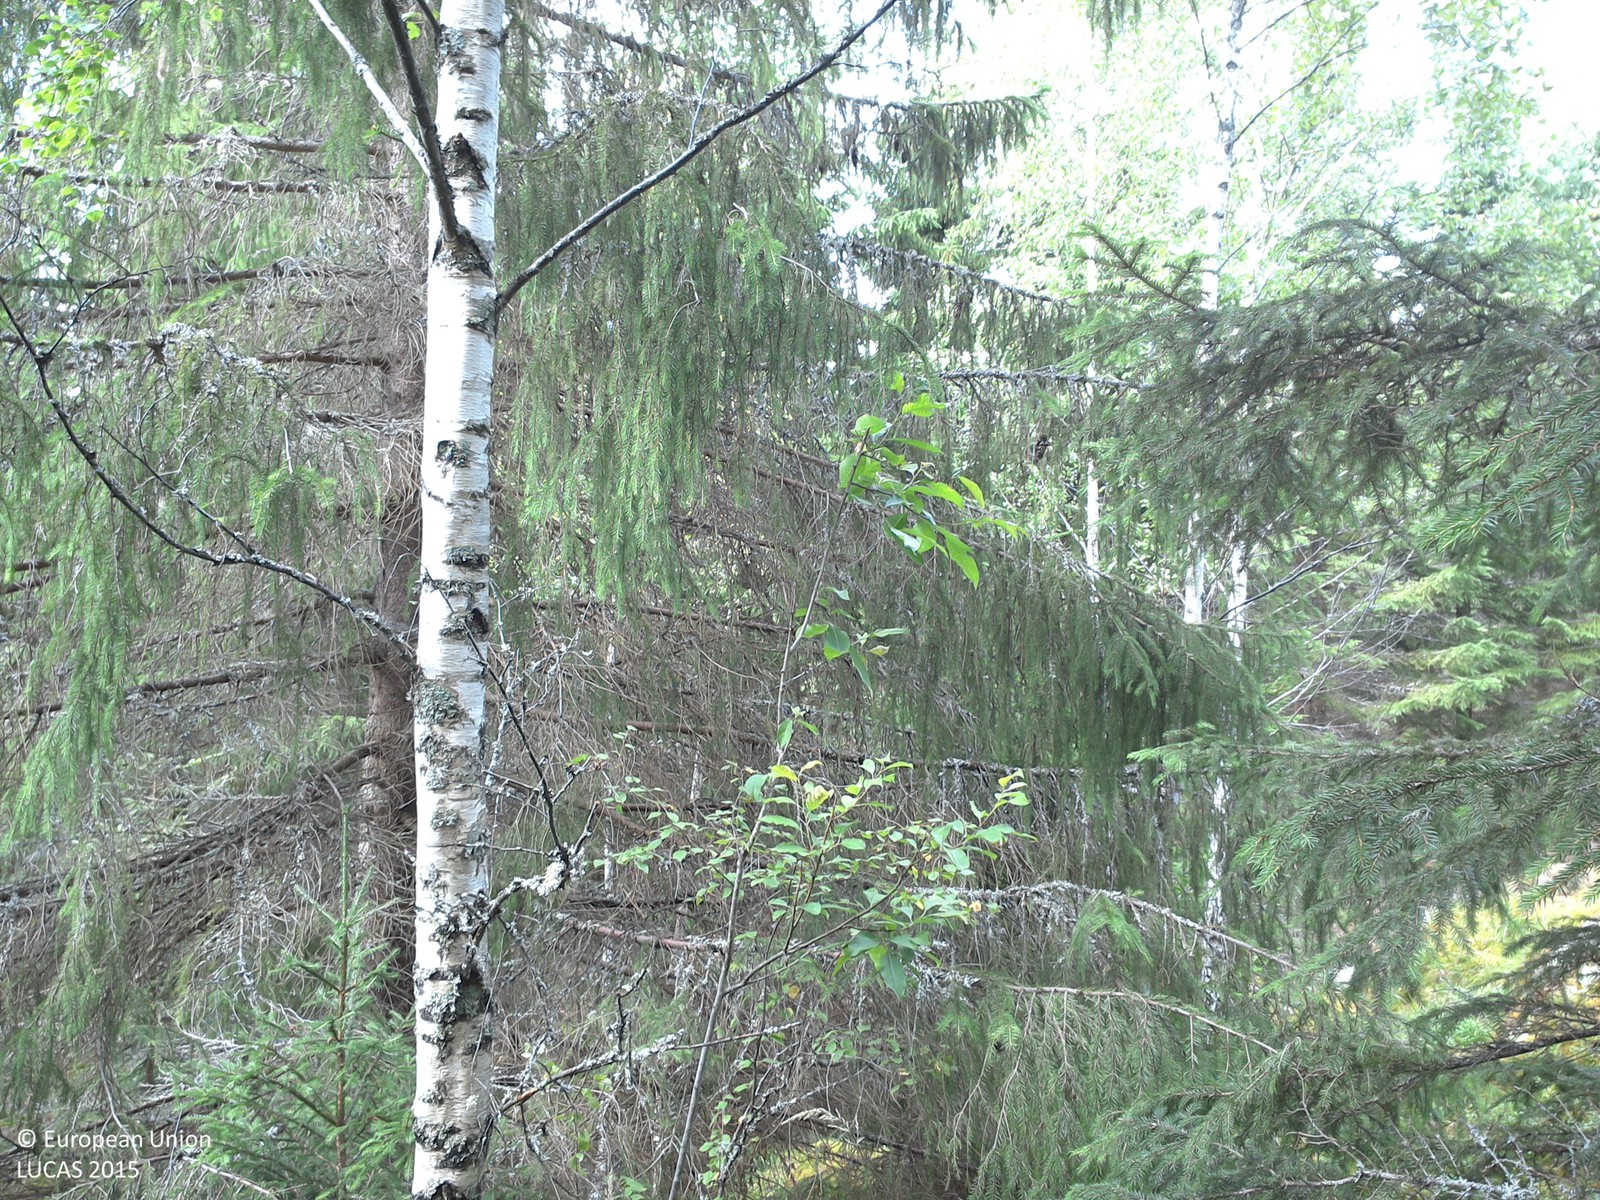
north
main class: Woodland
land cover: Spruce dominated coniferous woodland
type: boreal forest
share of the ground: 50 - 75 %
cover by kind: coniferous forest trees 60 %, lichens and mosses 30 %, herbaceous plants 10 %
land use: Forestry
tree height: > 5 m
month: August
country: SE
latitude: 58.1286
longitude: 15.4117
